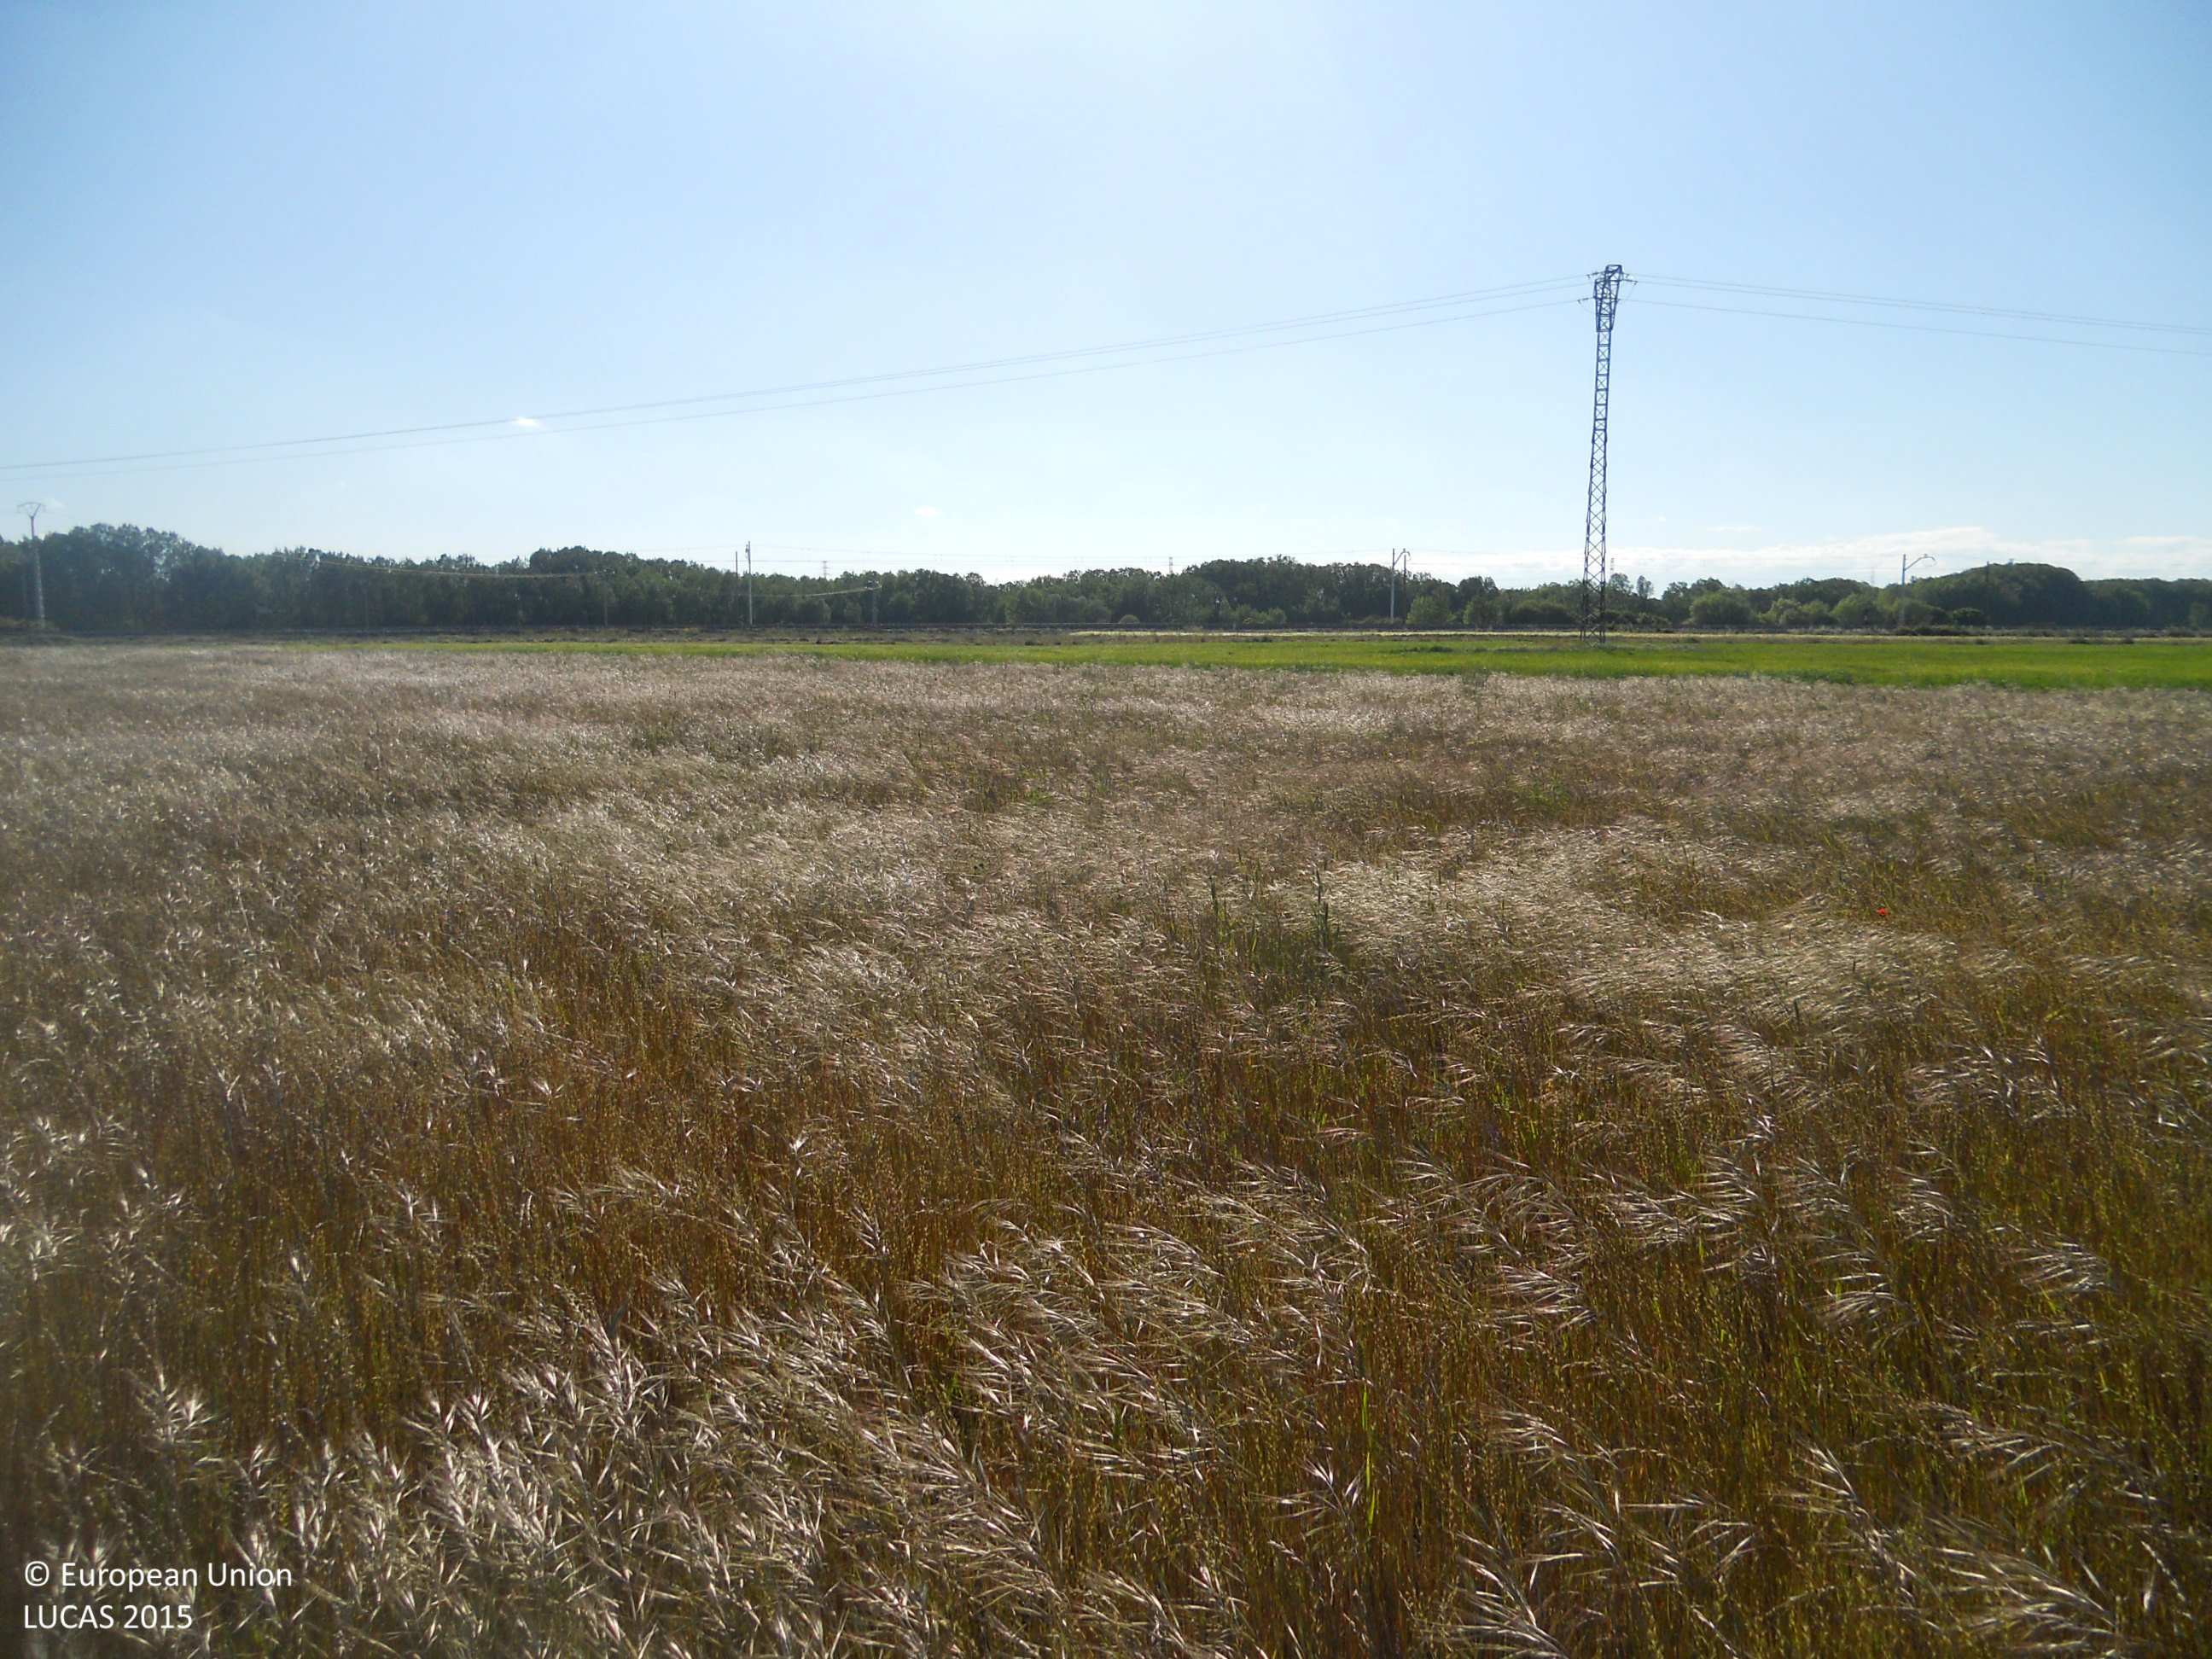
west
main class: Grassland
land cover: Spontaneously vegetated surfaces
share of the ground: > 75 %
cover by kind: herbaceous plants 100 %
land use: Fallow land
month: May
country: ES
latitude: 42.4313
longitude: -4.3545
